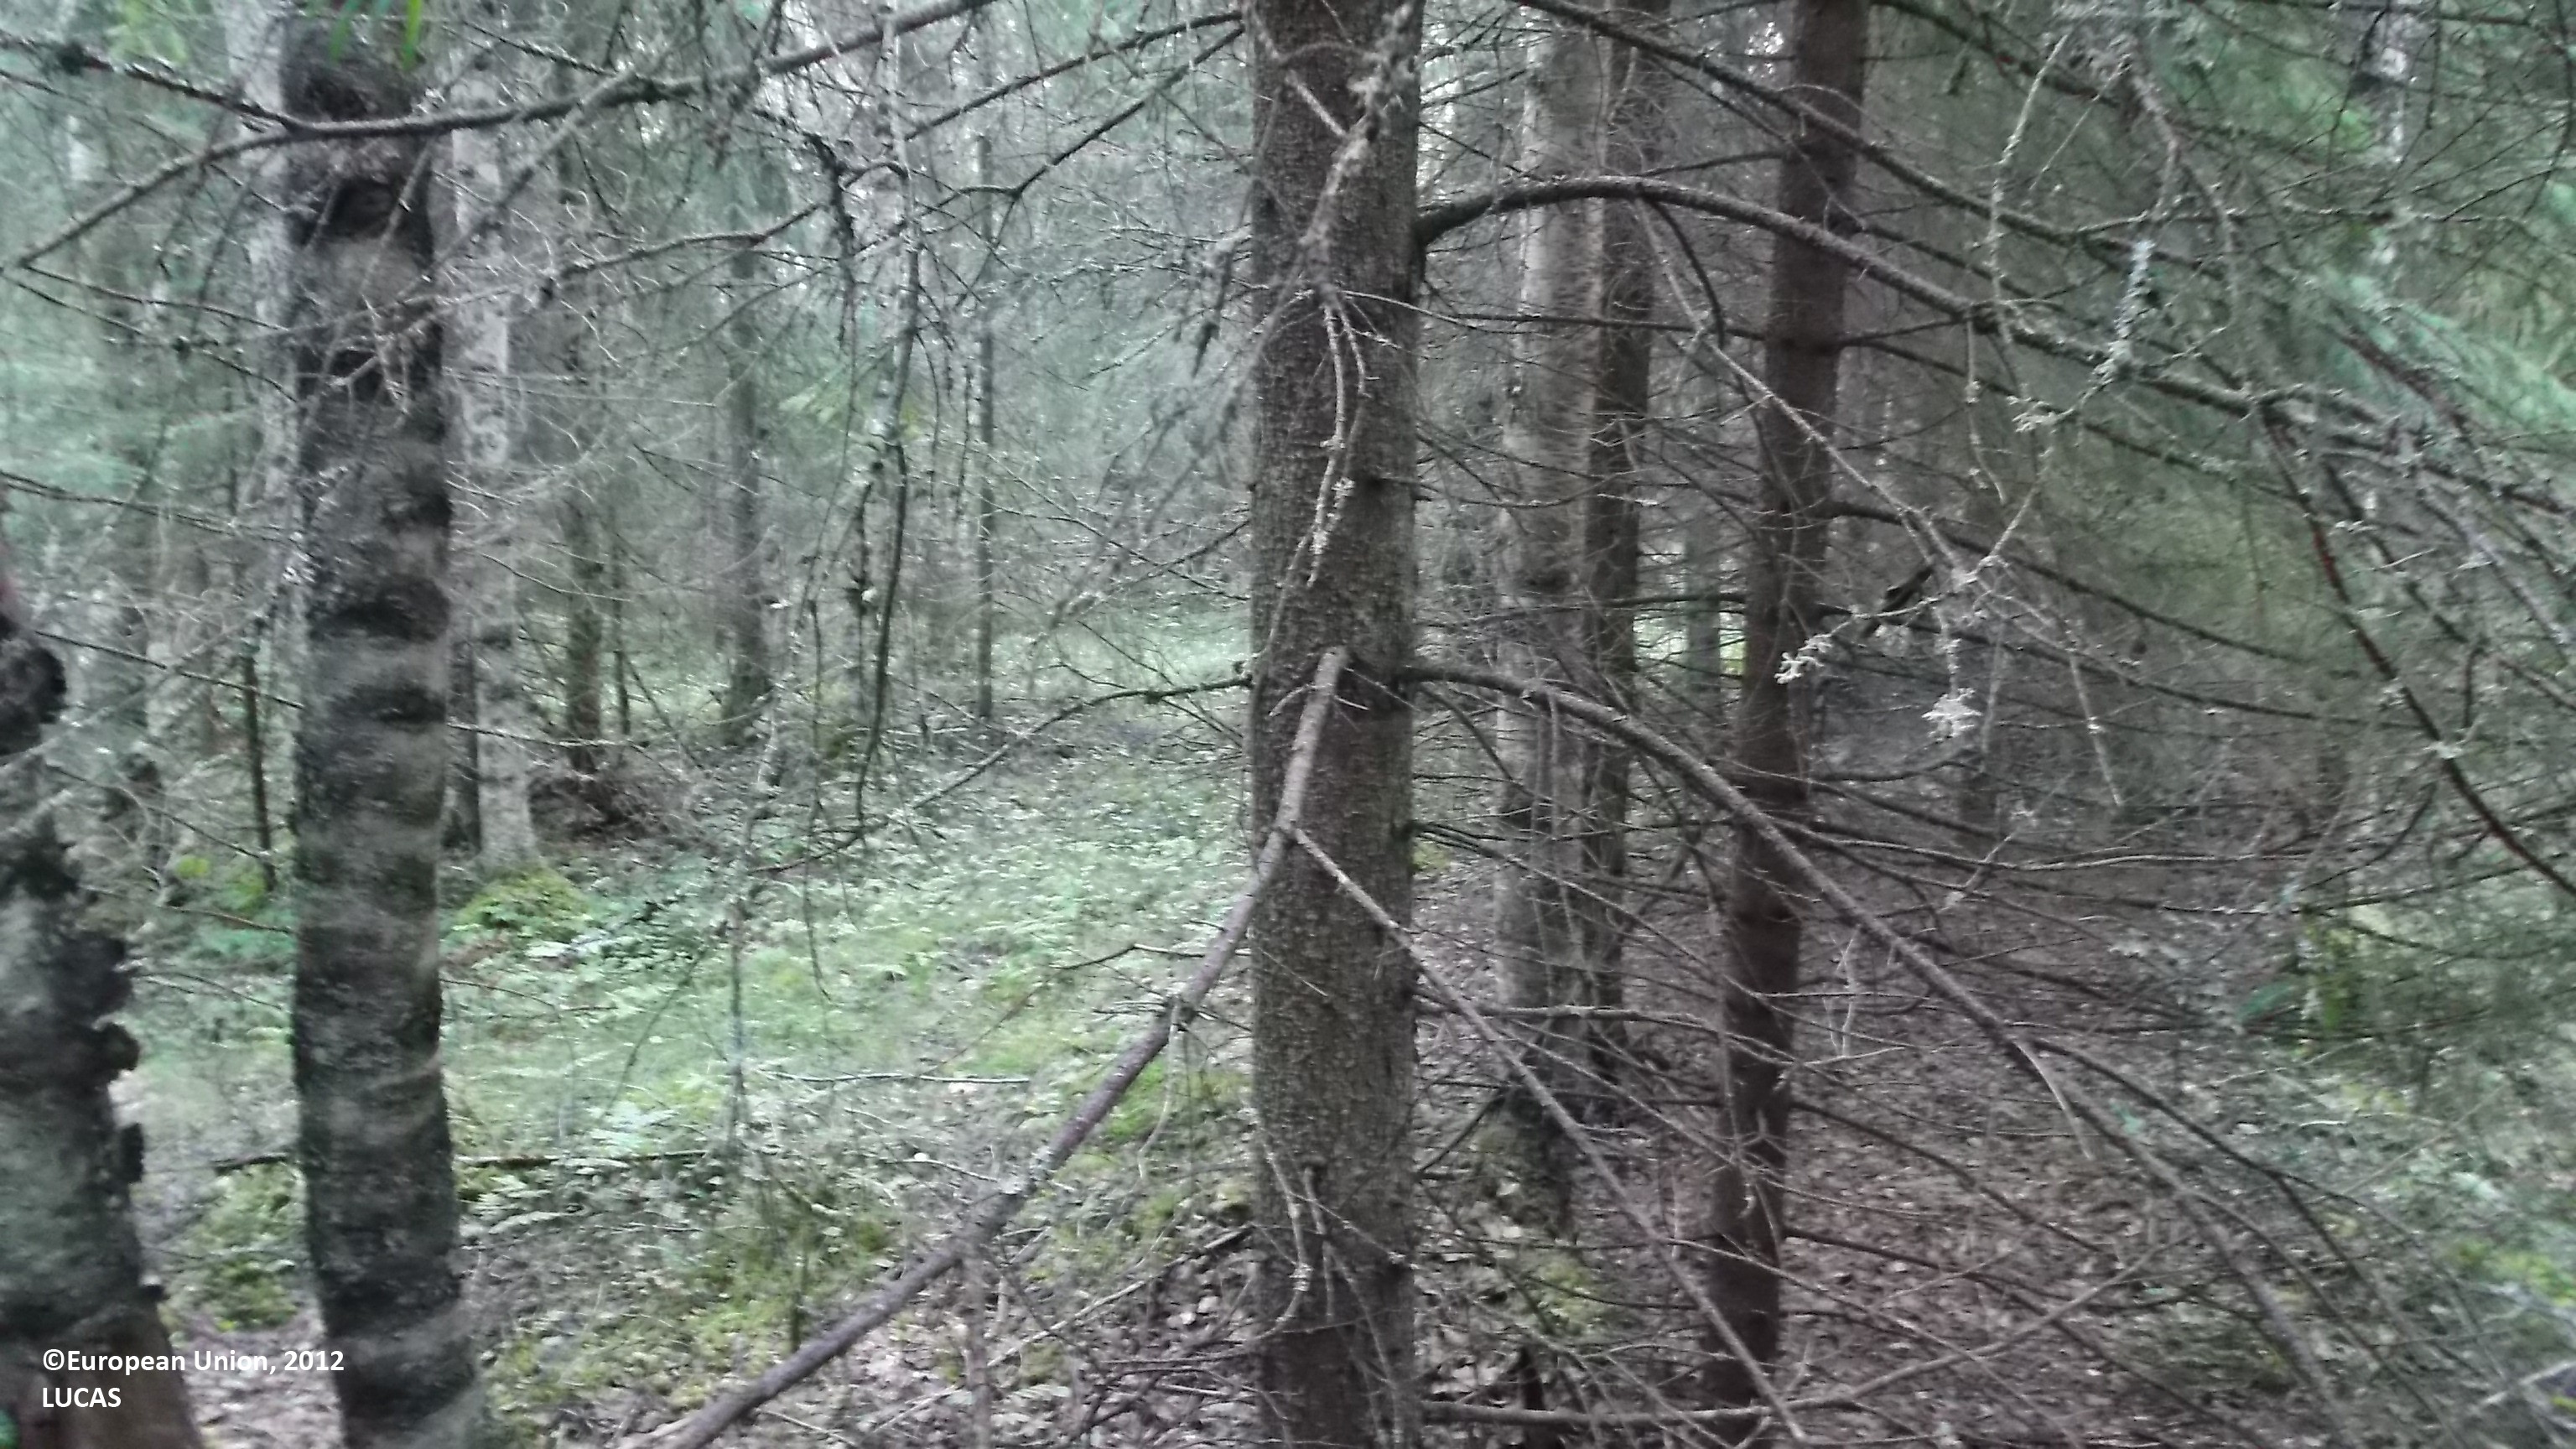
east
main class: Woodland
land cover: Other mixed woodland
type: boreal forest
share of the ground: > 75 %
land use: Forestry
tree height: > 5 m
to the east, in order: Other mixed woodland; Spontaneously vegetated surfaces; Other mixed woodland; Ditches and canals; Other mixed woodland; Ditches and canals; Other mixed woodland
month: July
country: FI
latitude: 63.3611
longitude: 23.8835
